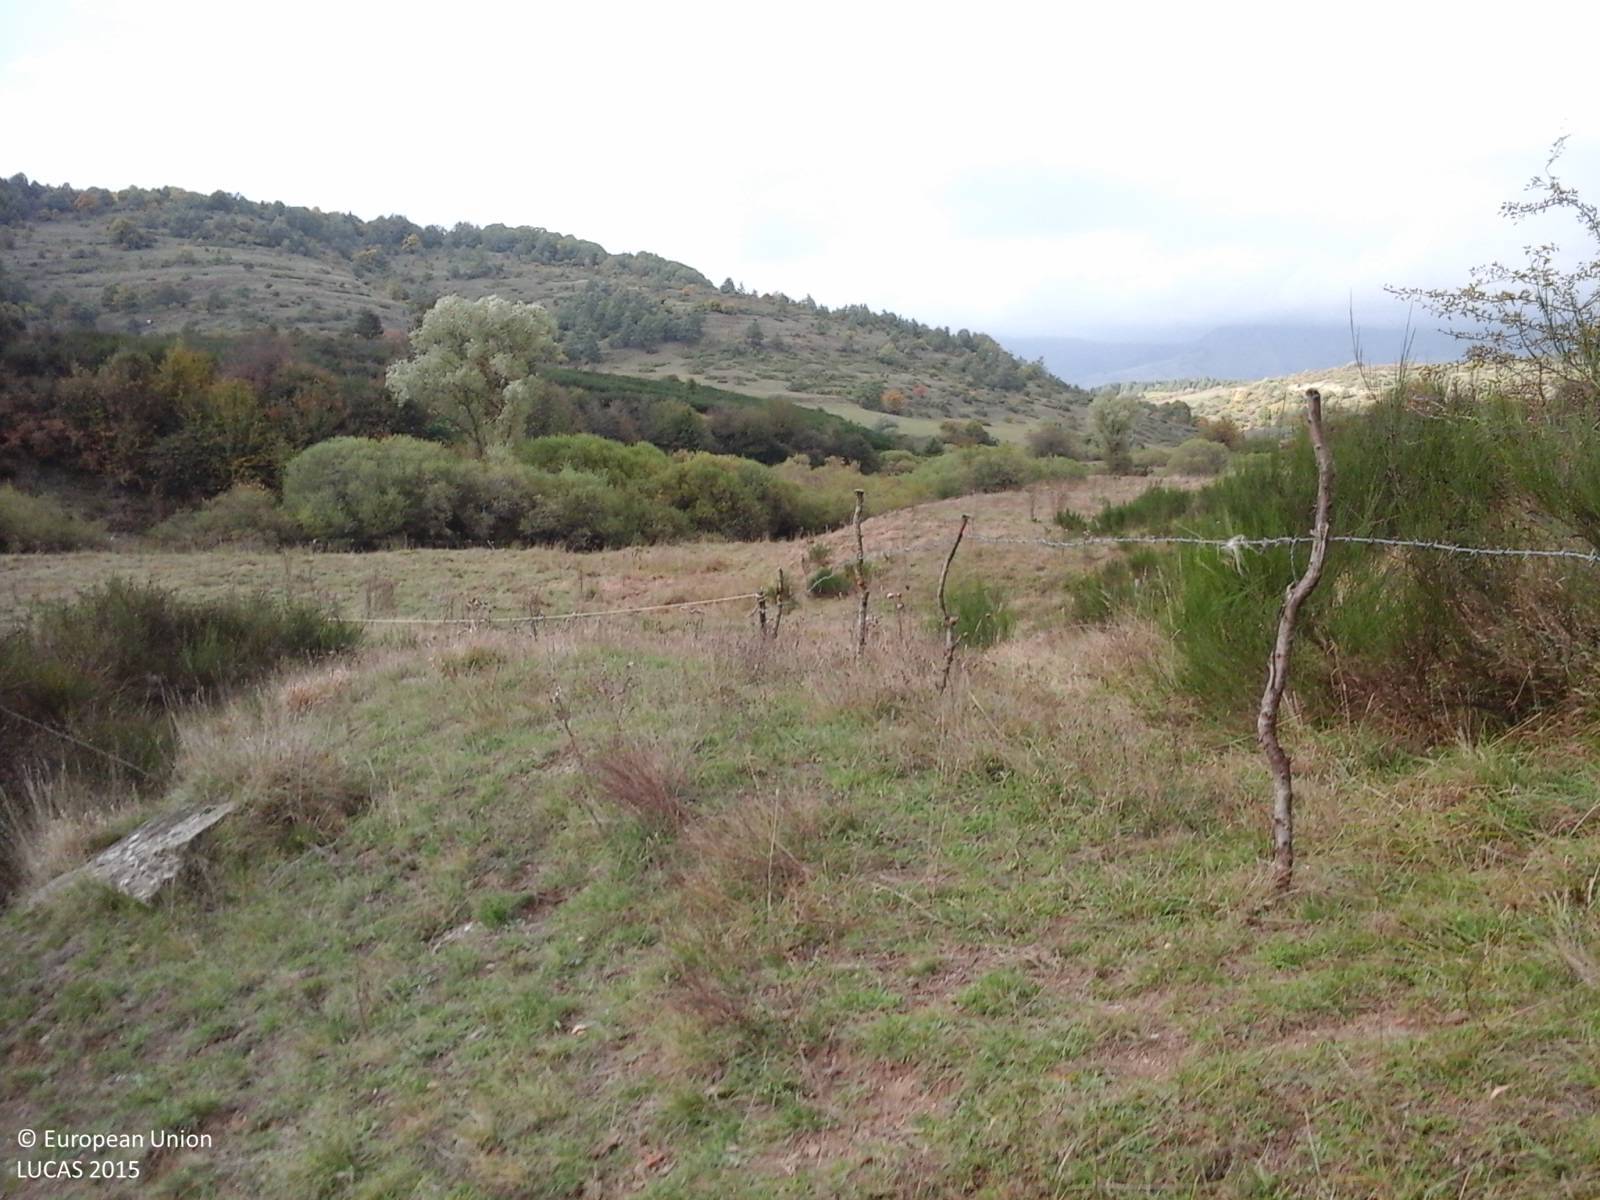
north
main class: Grassland
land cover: Grassland without tree/shrub cover
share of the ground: > 75 %
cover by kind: herbaceous plants 100 %
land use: Agriculture (excluding fallow land and kitchen gardens)
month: October
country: IT
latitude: 42.5817
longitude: 13.3161
